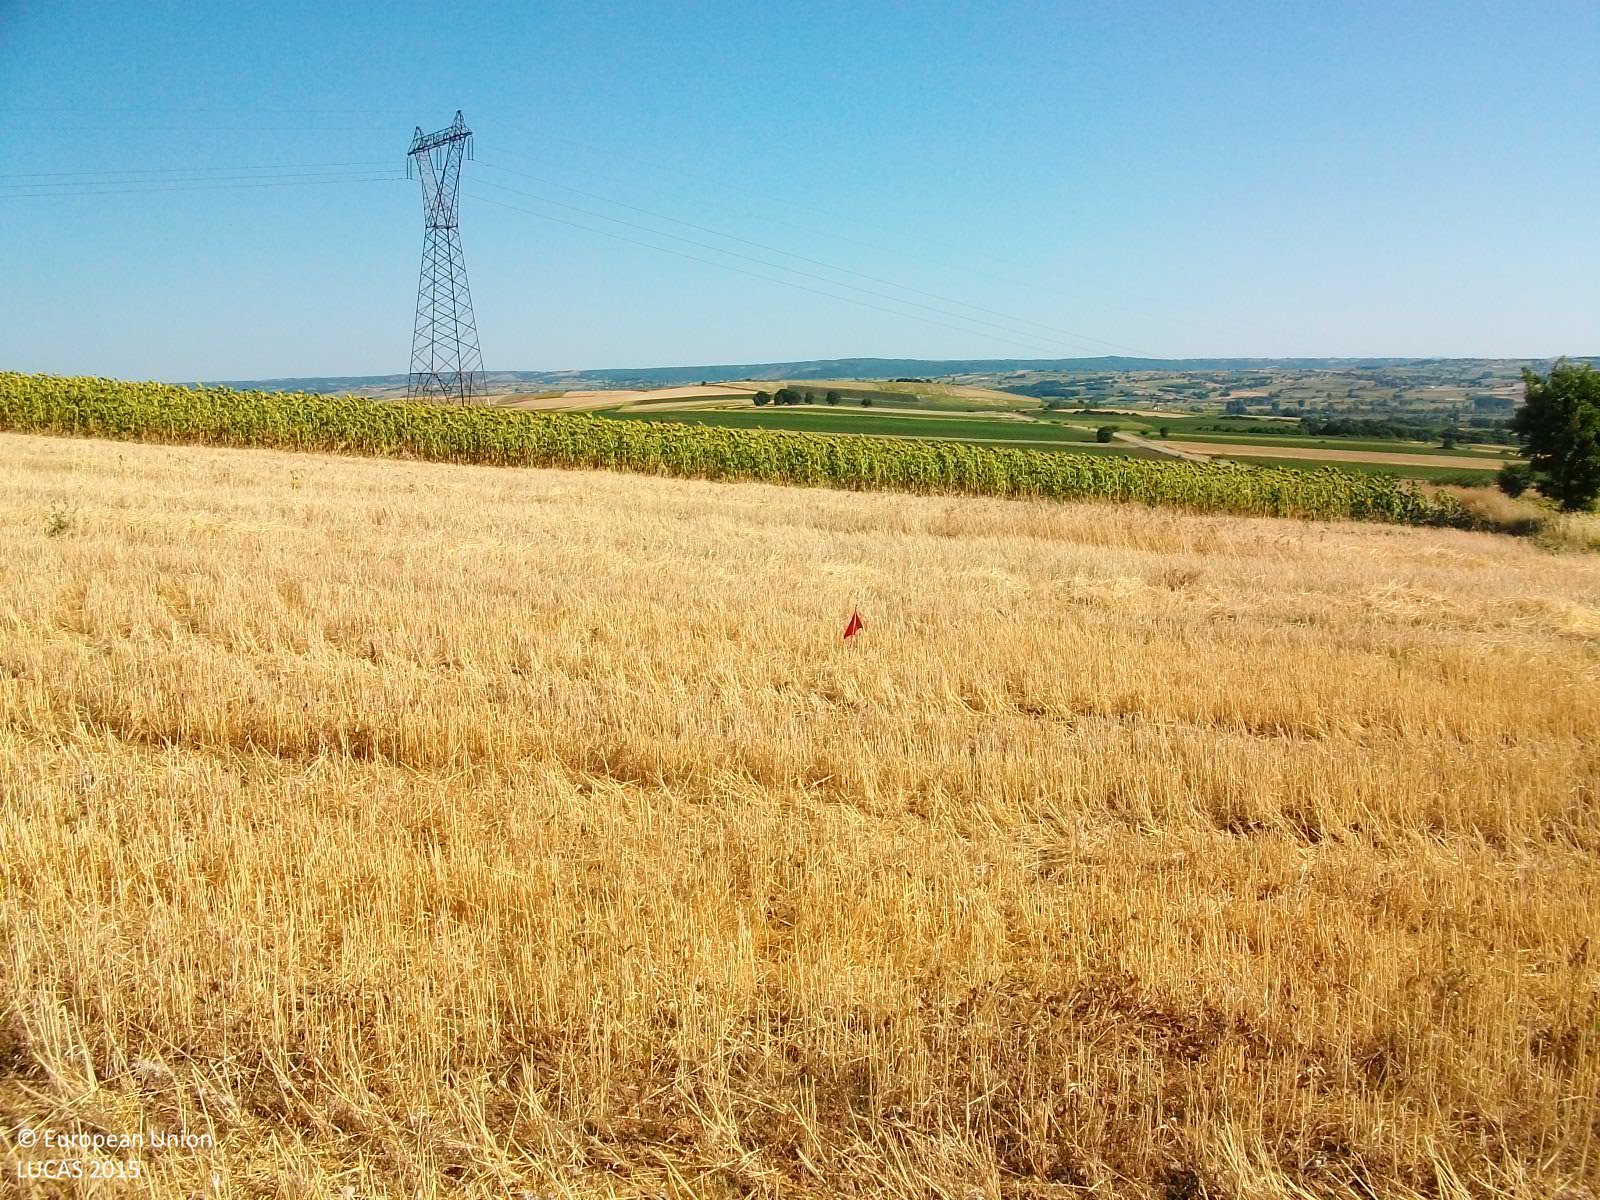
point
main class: Cropland
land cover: Common wheat
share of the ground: > 75 %
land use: Agriculture (excluding fallow land and kitchen gardens)
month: July
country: GR
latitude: 41.4667
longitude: 26.3221
